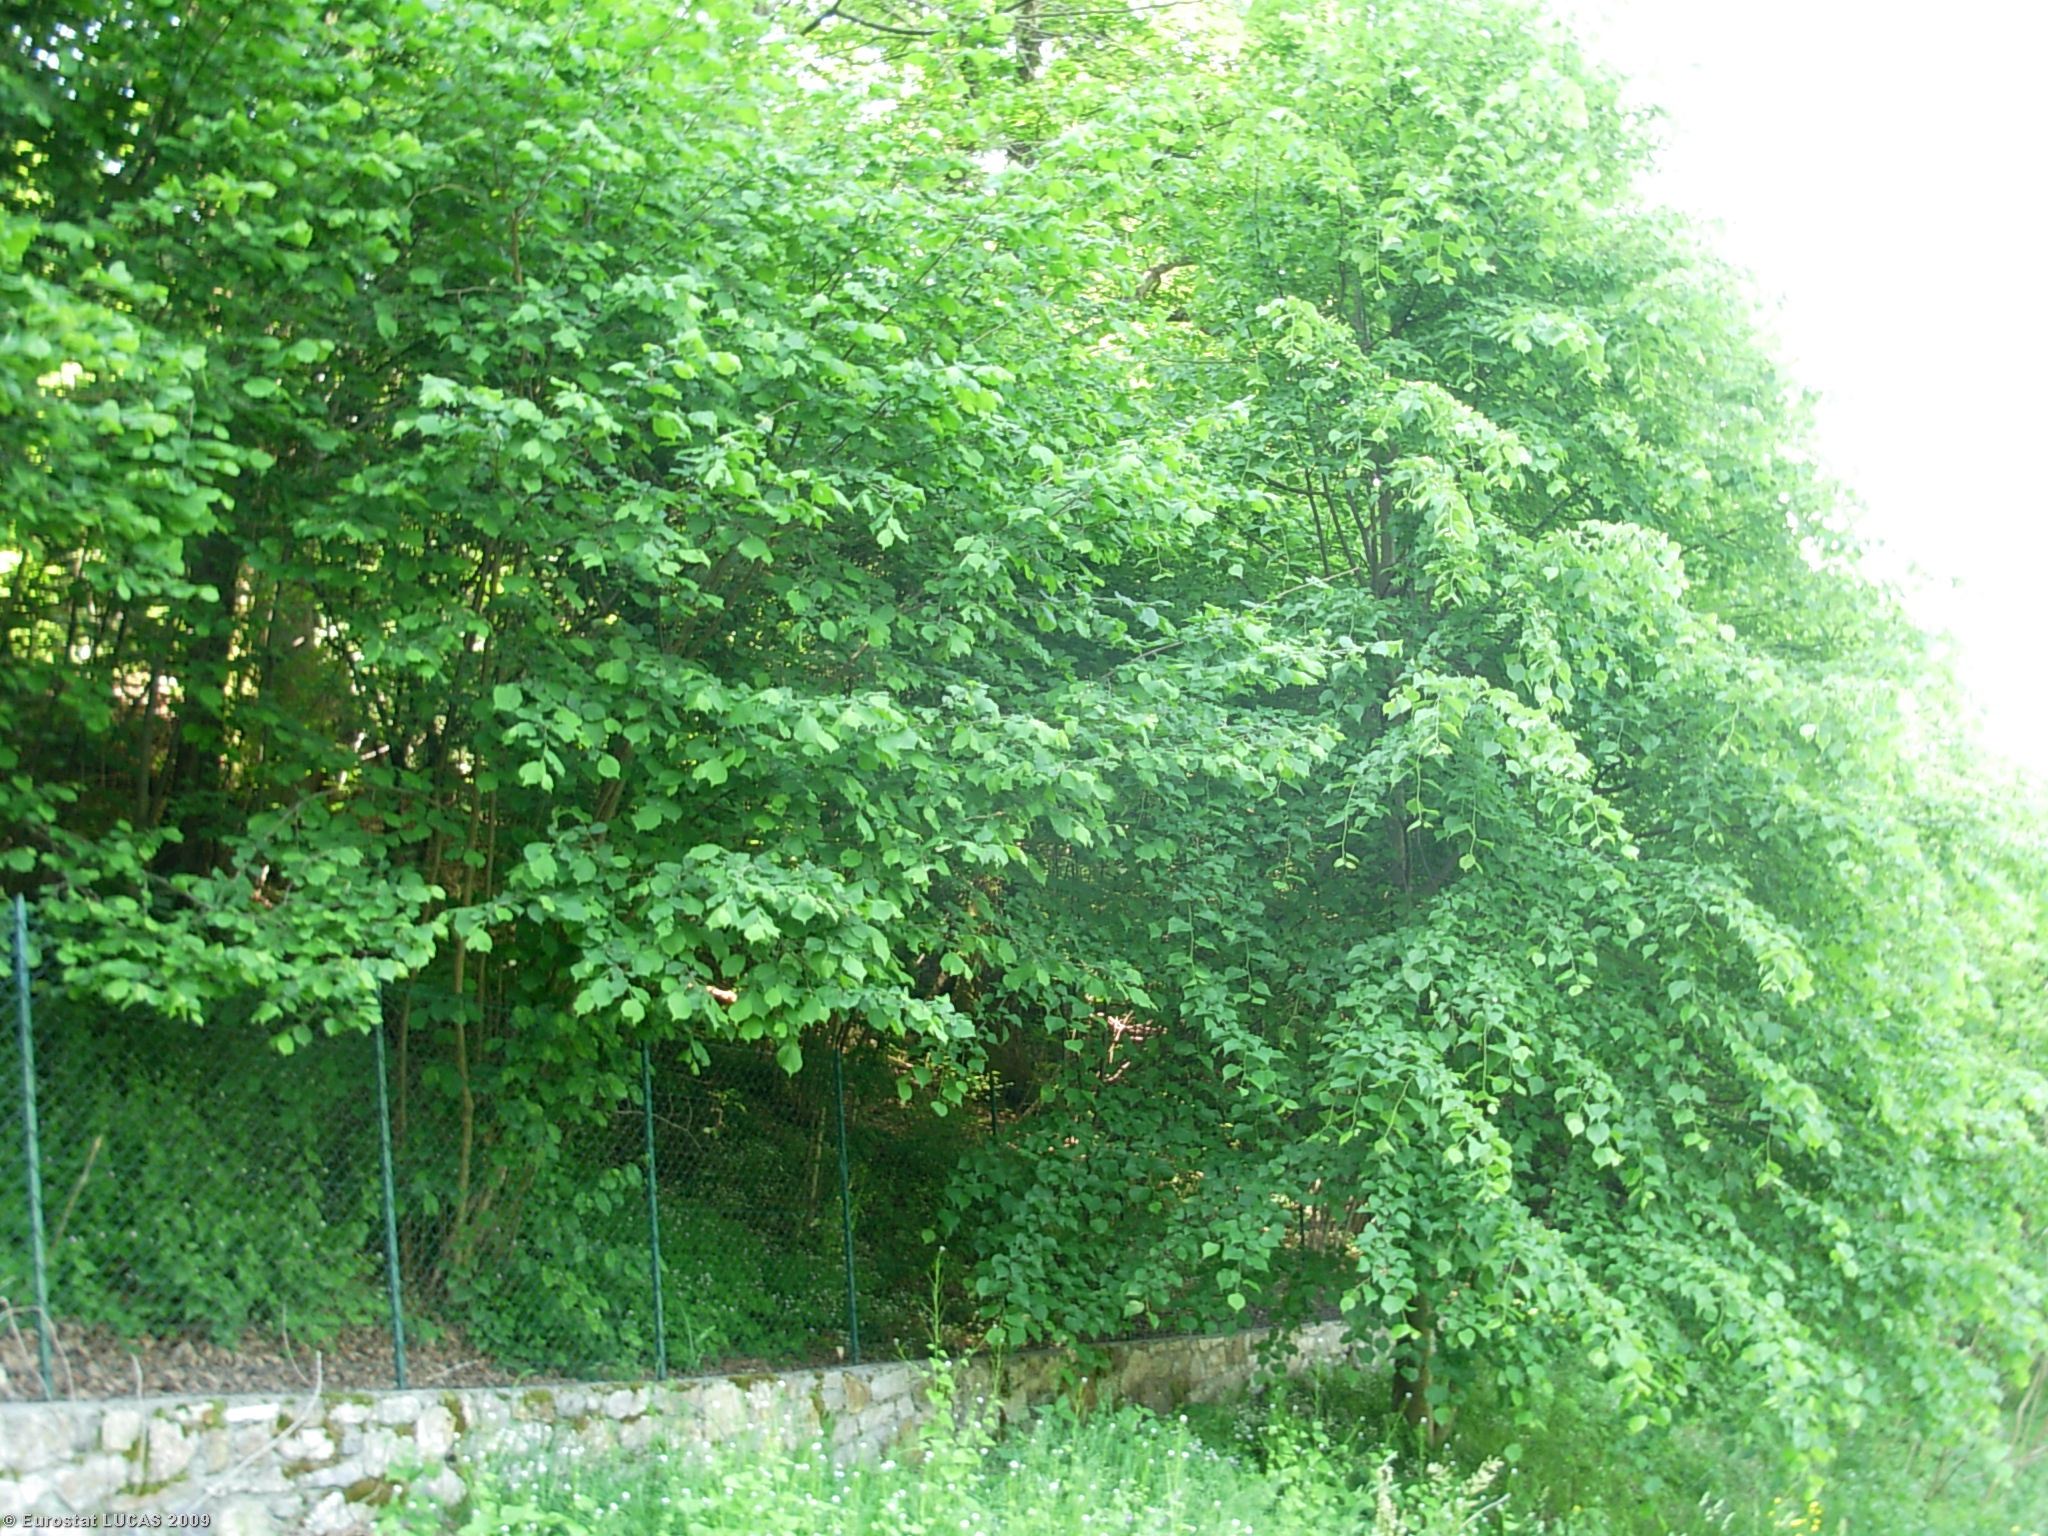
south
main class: Grassland
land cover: Grassland with sparse tree/shrub cover
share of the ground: < 10 %
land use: Agriculture (excluding fallow land and kitchen gardens)
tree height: > 5 m
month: May
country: IT
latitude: 45.7744
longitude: 10.2696
